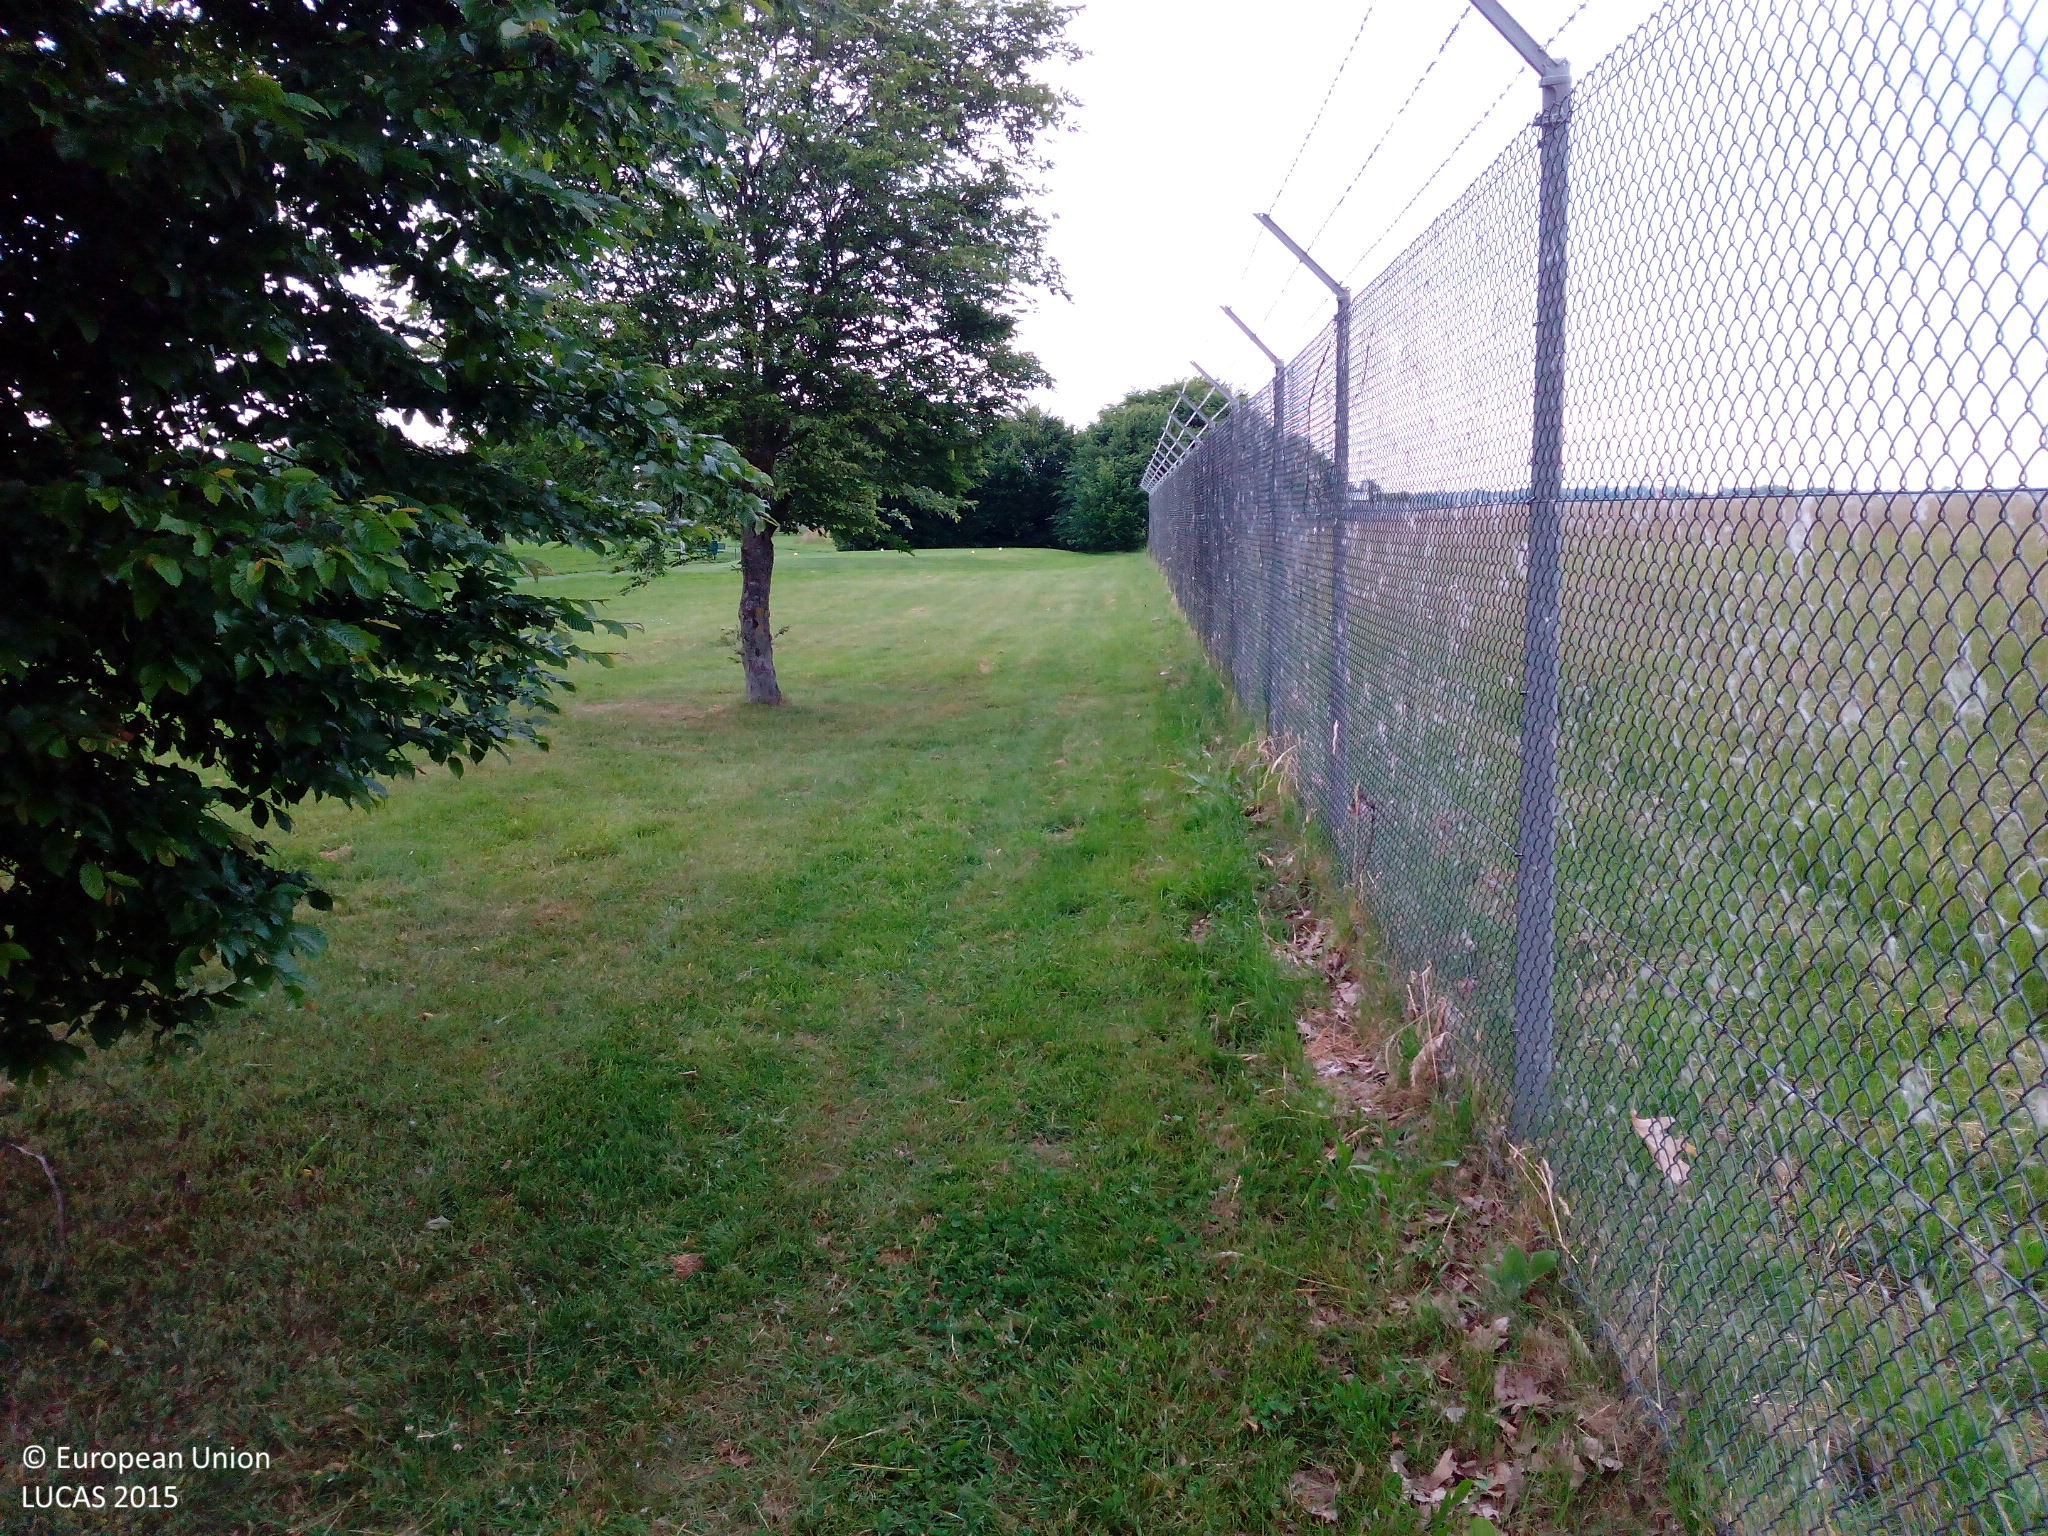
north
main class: Grassland
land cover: Grassland without tree/shrub cover
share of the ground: > 75 %
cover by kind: herbaceous plants 95 %, consolidated bare surface 5 %
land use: Air transport
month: May
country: DE
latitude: 48.7828
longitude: 8.0817
